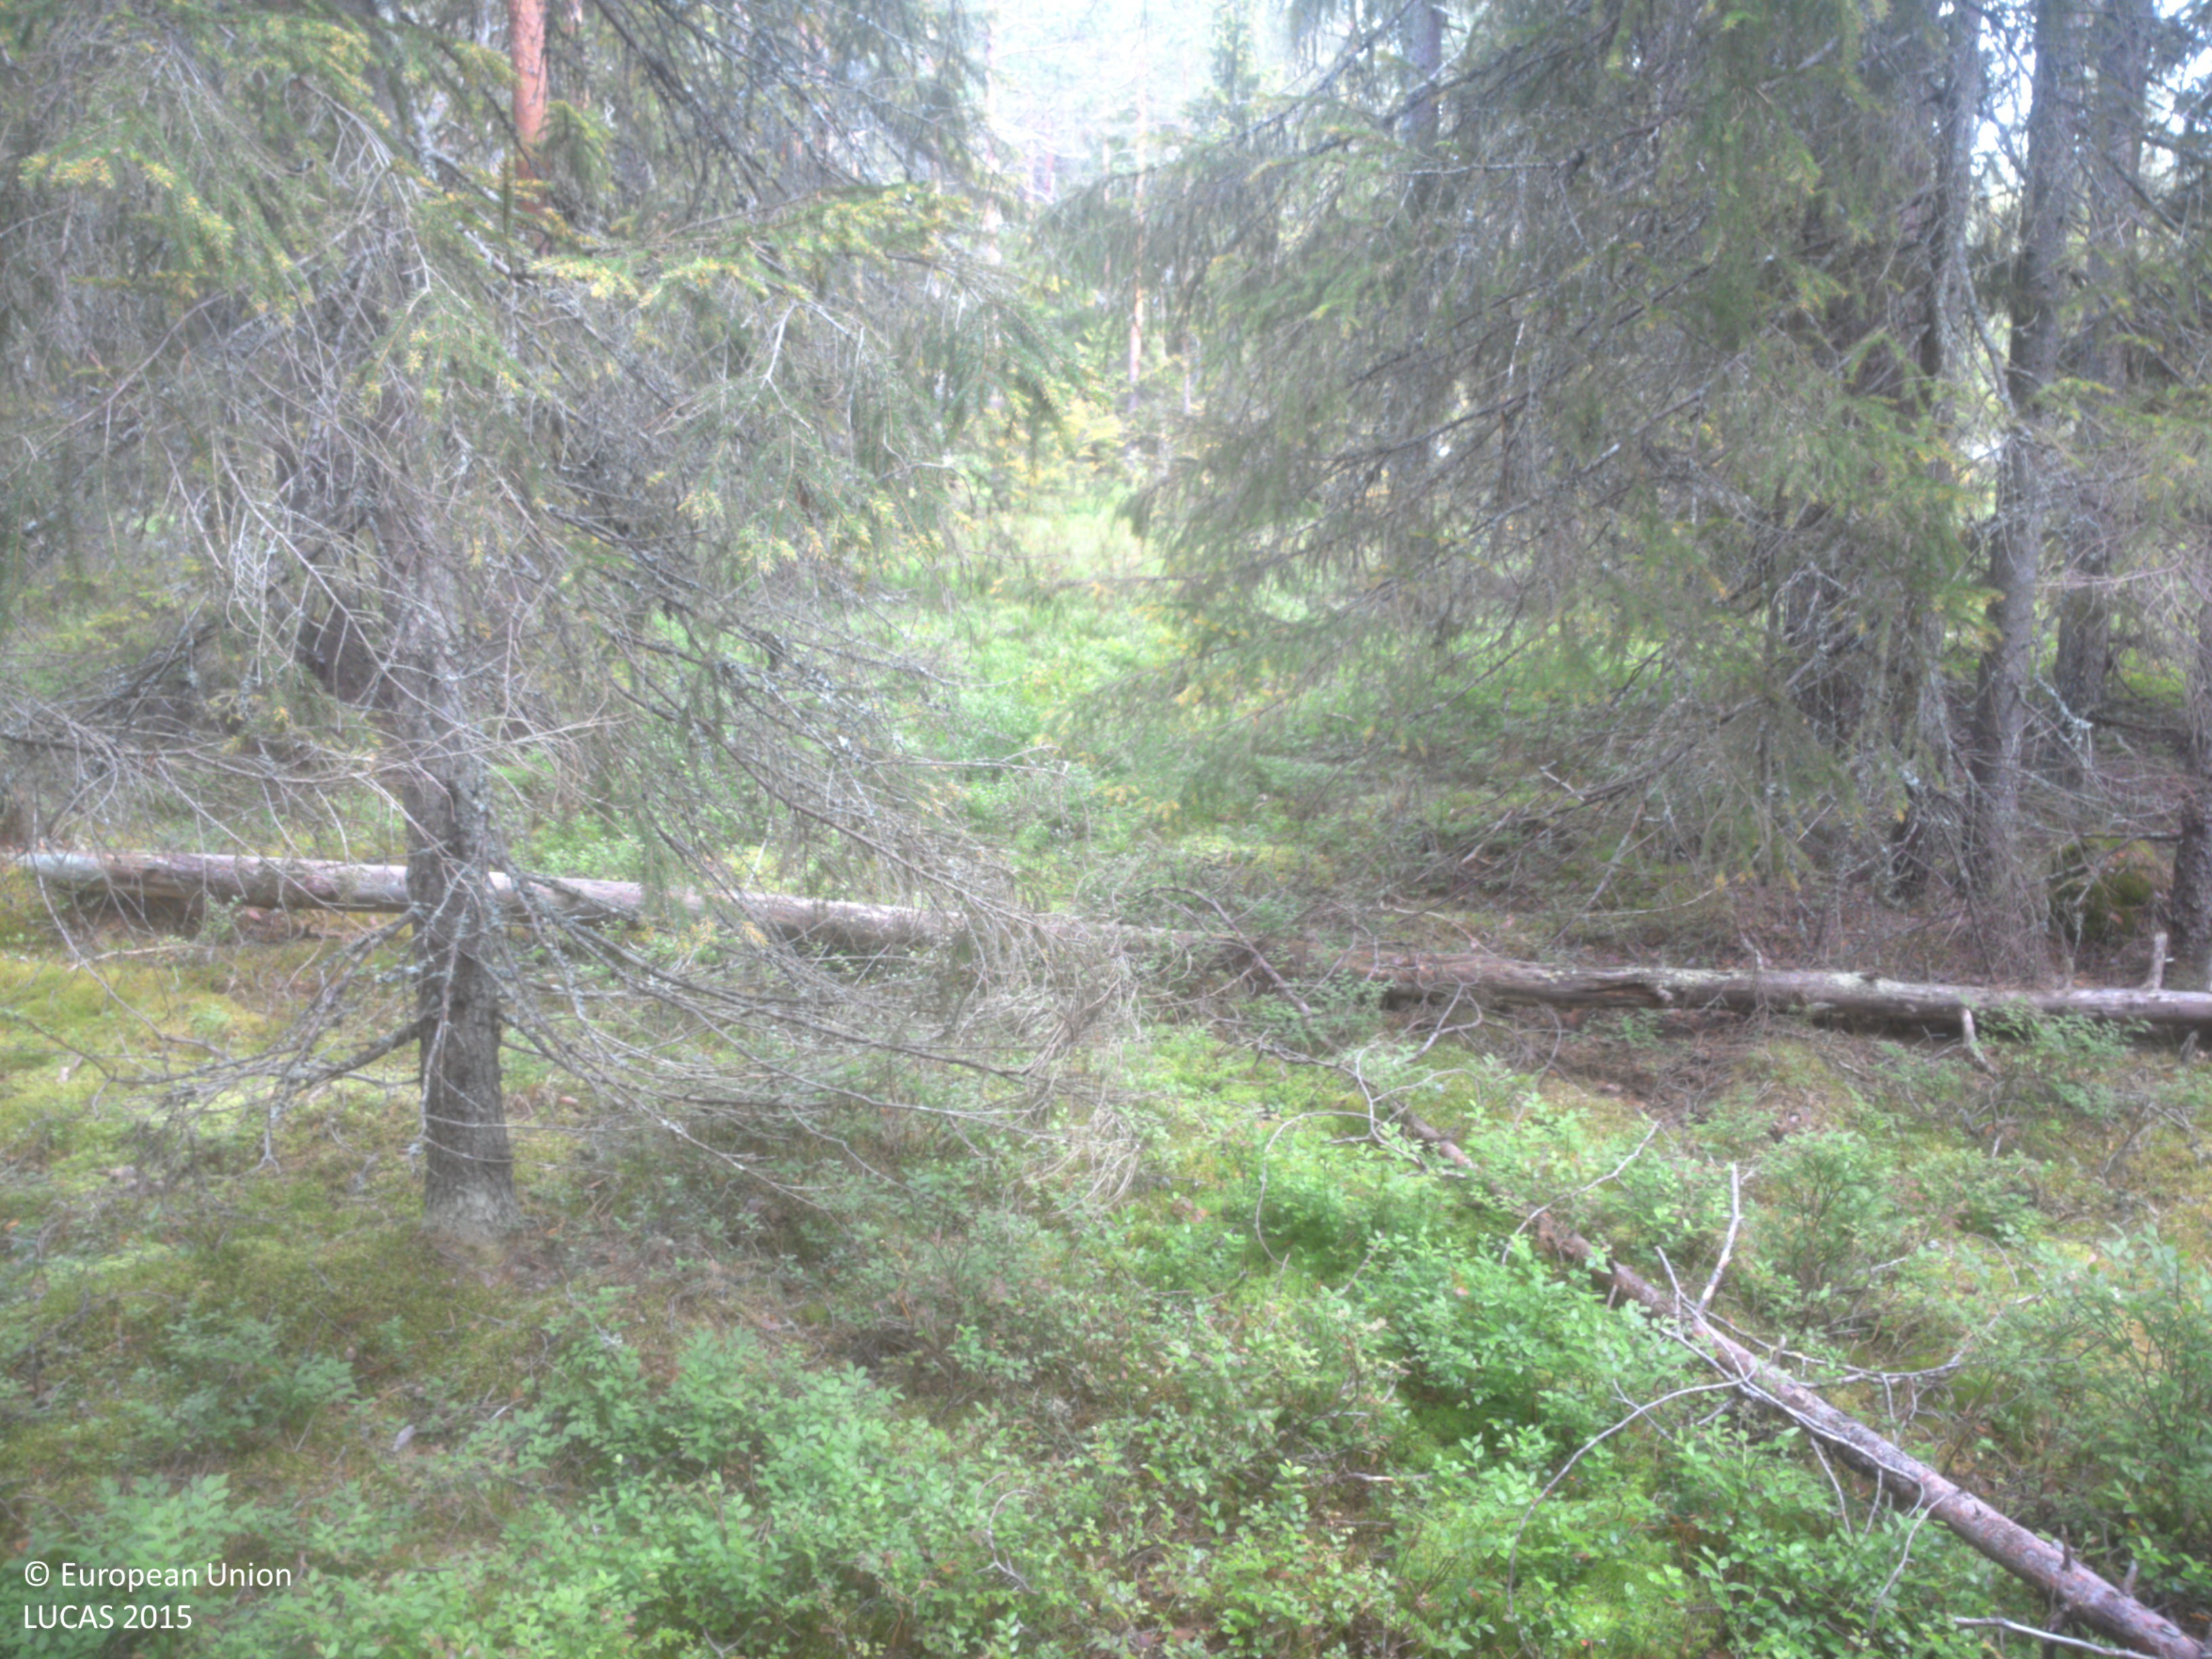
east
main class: Woodland
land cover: Other coniferous woodland
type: boreal forest
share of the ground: 50 - 75 %
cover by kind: coniferous forest trees 70 %, shrubs 20 %, lichens and mosses 10 %
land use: Forestry
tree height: > 5 m
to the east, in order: Other coniferous woodland; Ditches and canals; Tracks; Other mixed woodland; Ditches and canals; Other mixed woodland
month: August
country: SE
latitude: 63.7428
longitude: 19.8873
